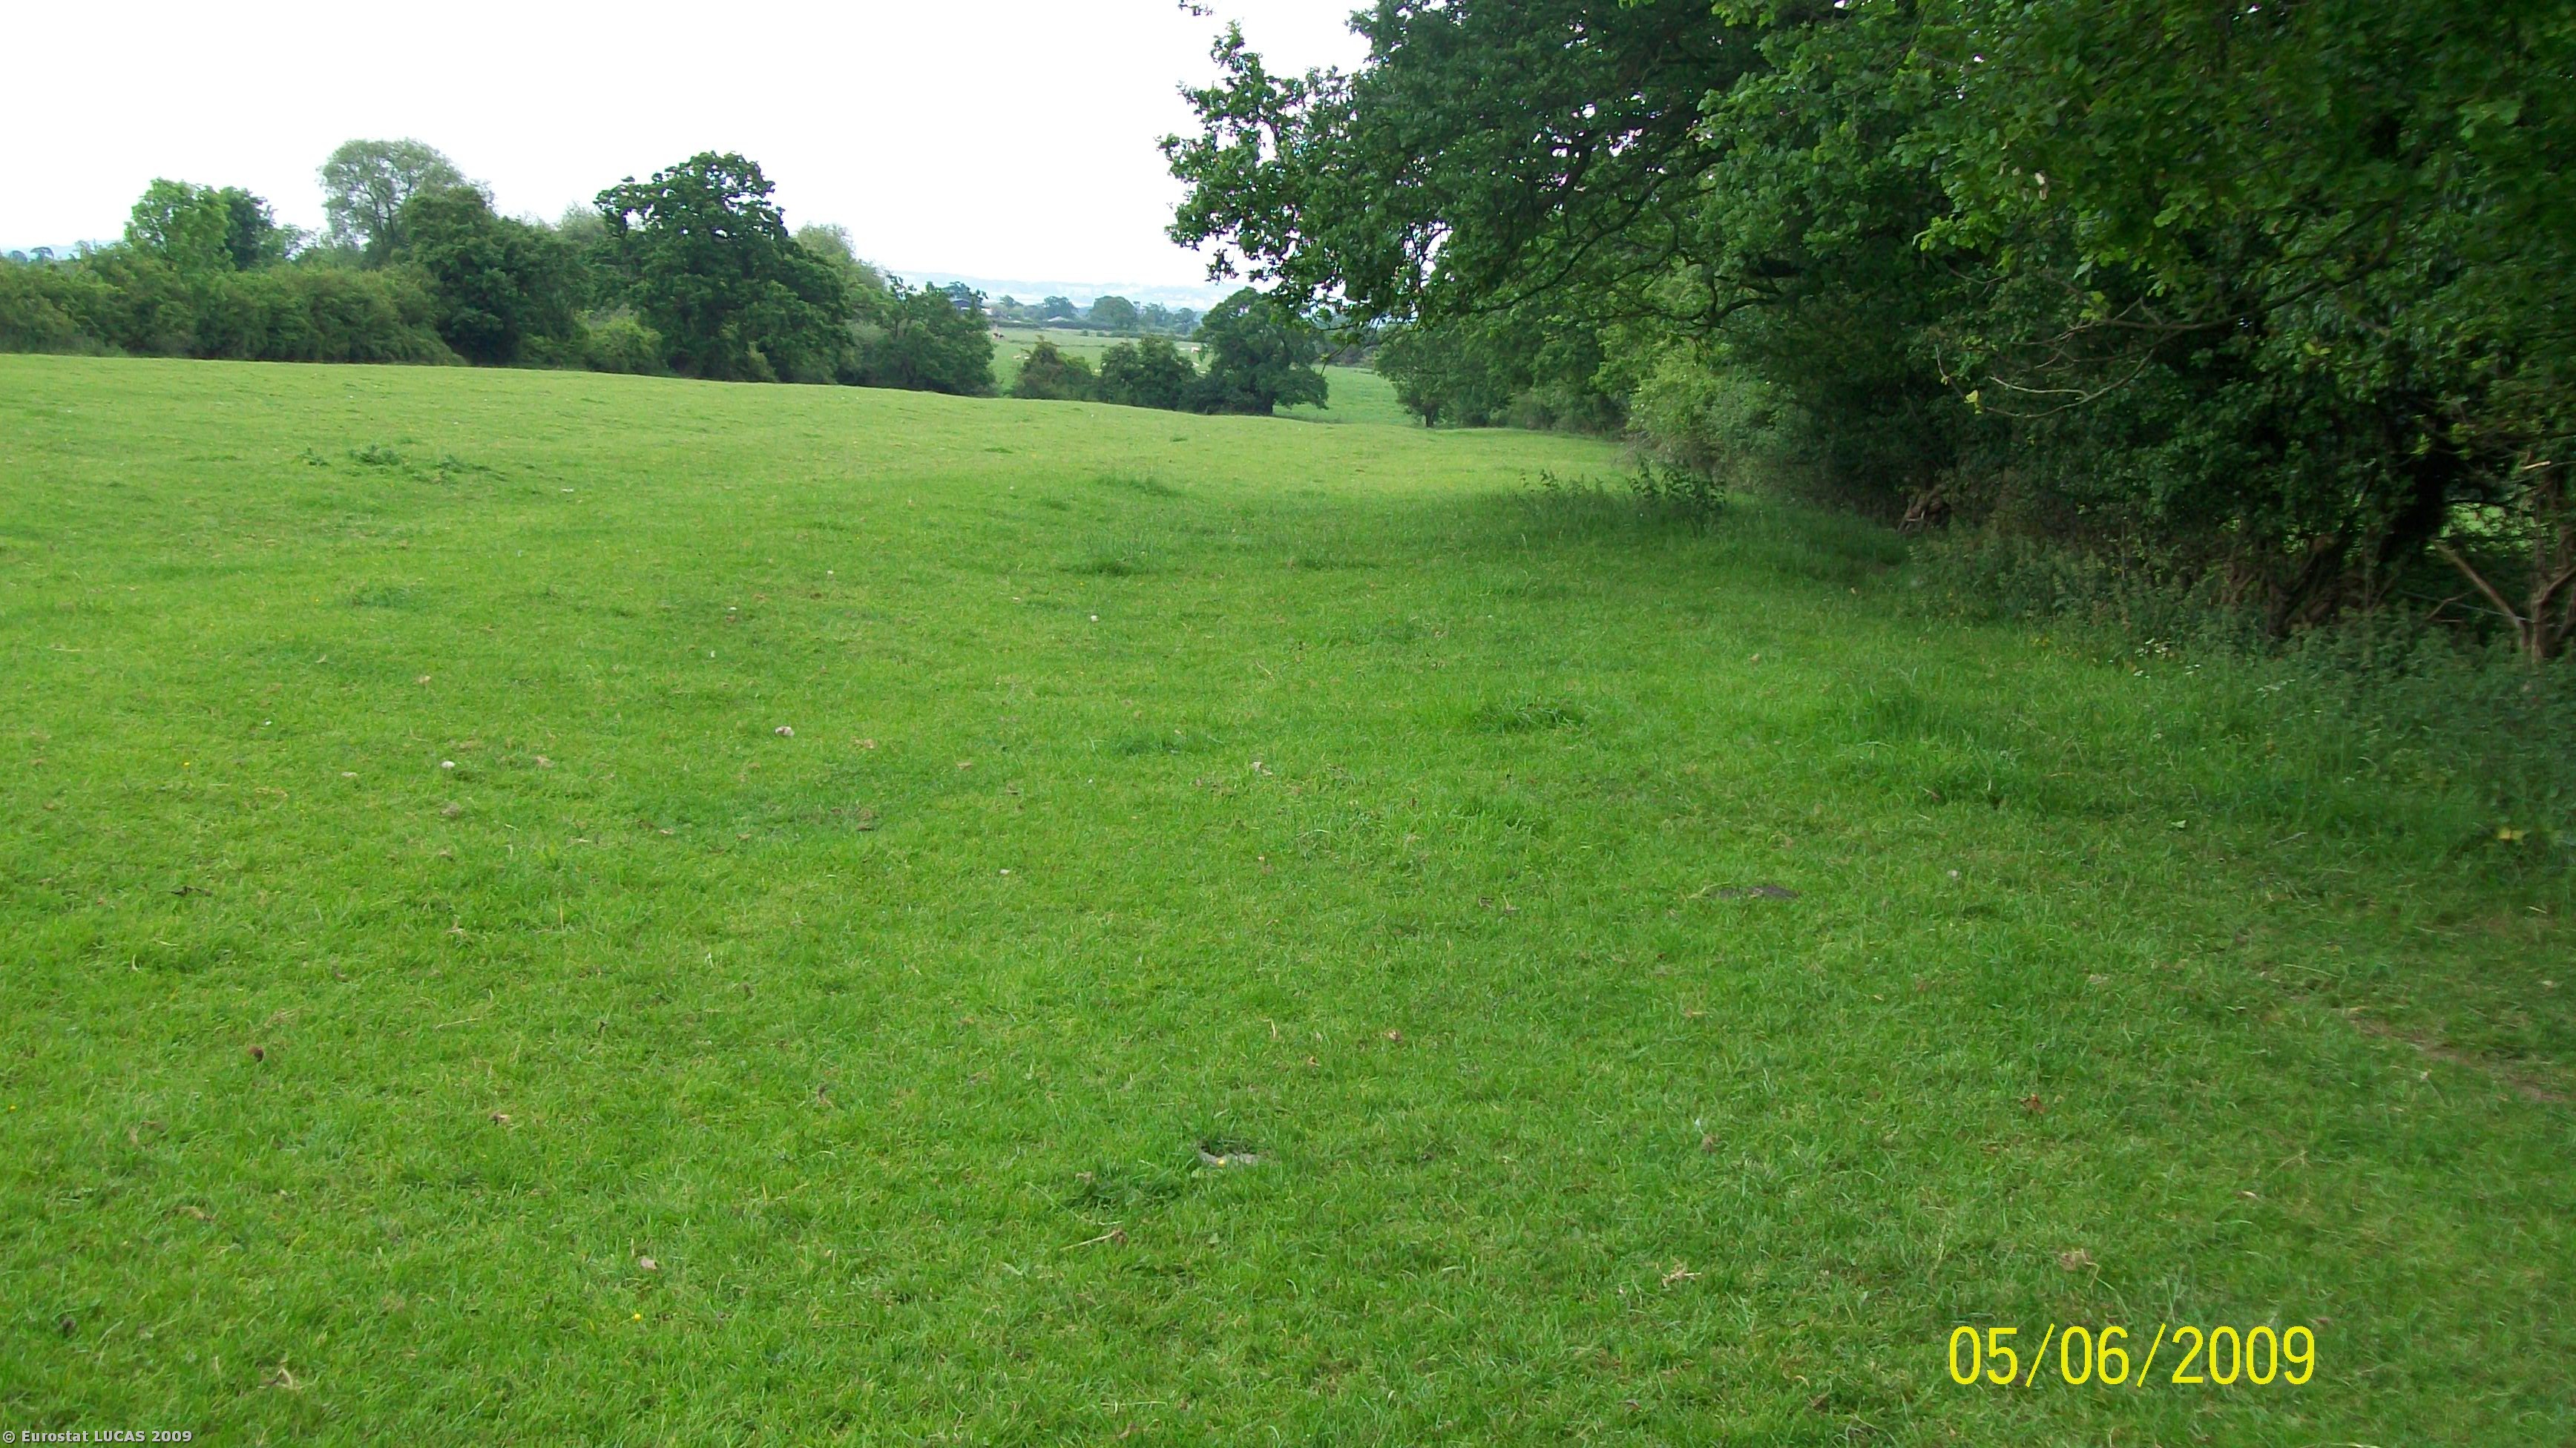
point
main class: Grassland
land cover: Grassland without tree/shrub cover
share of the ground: > 75 %
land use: Agriculture (excluding fallow land and kitchen gardens)
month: June
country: GB
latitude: 53.1243
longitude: -2.7574
